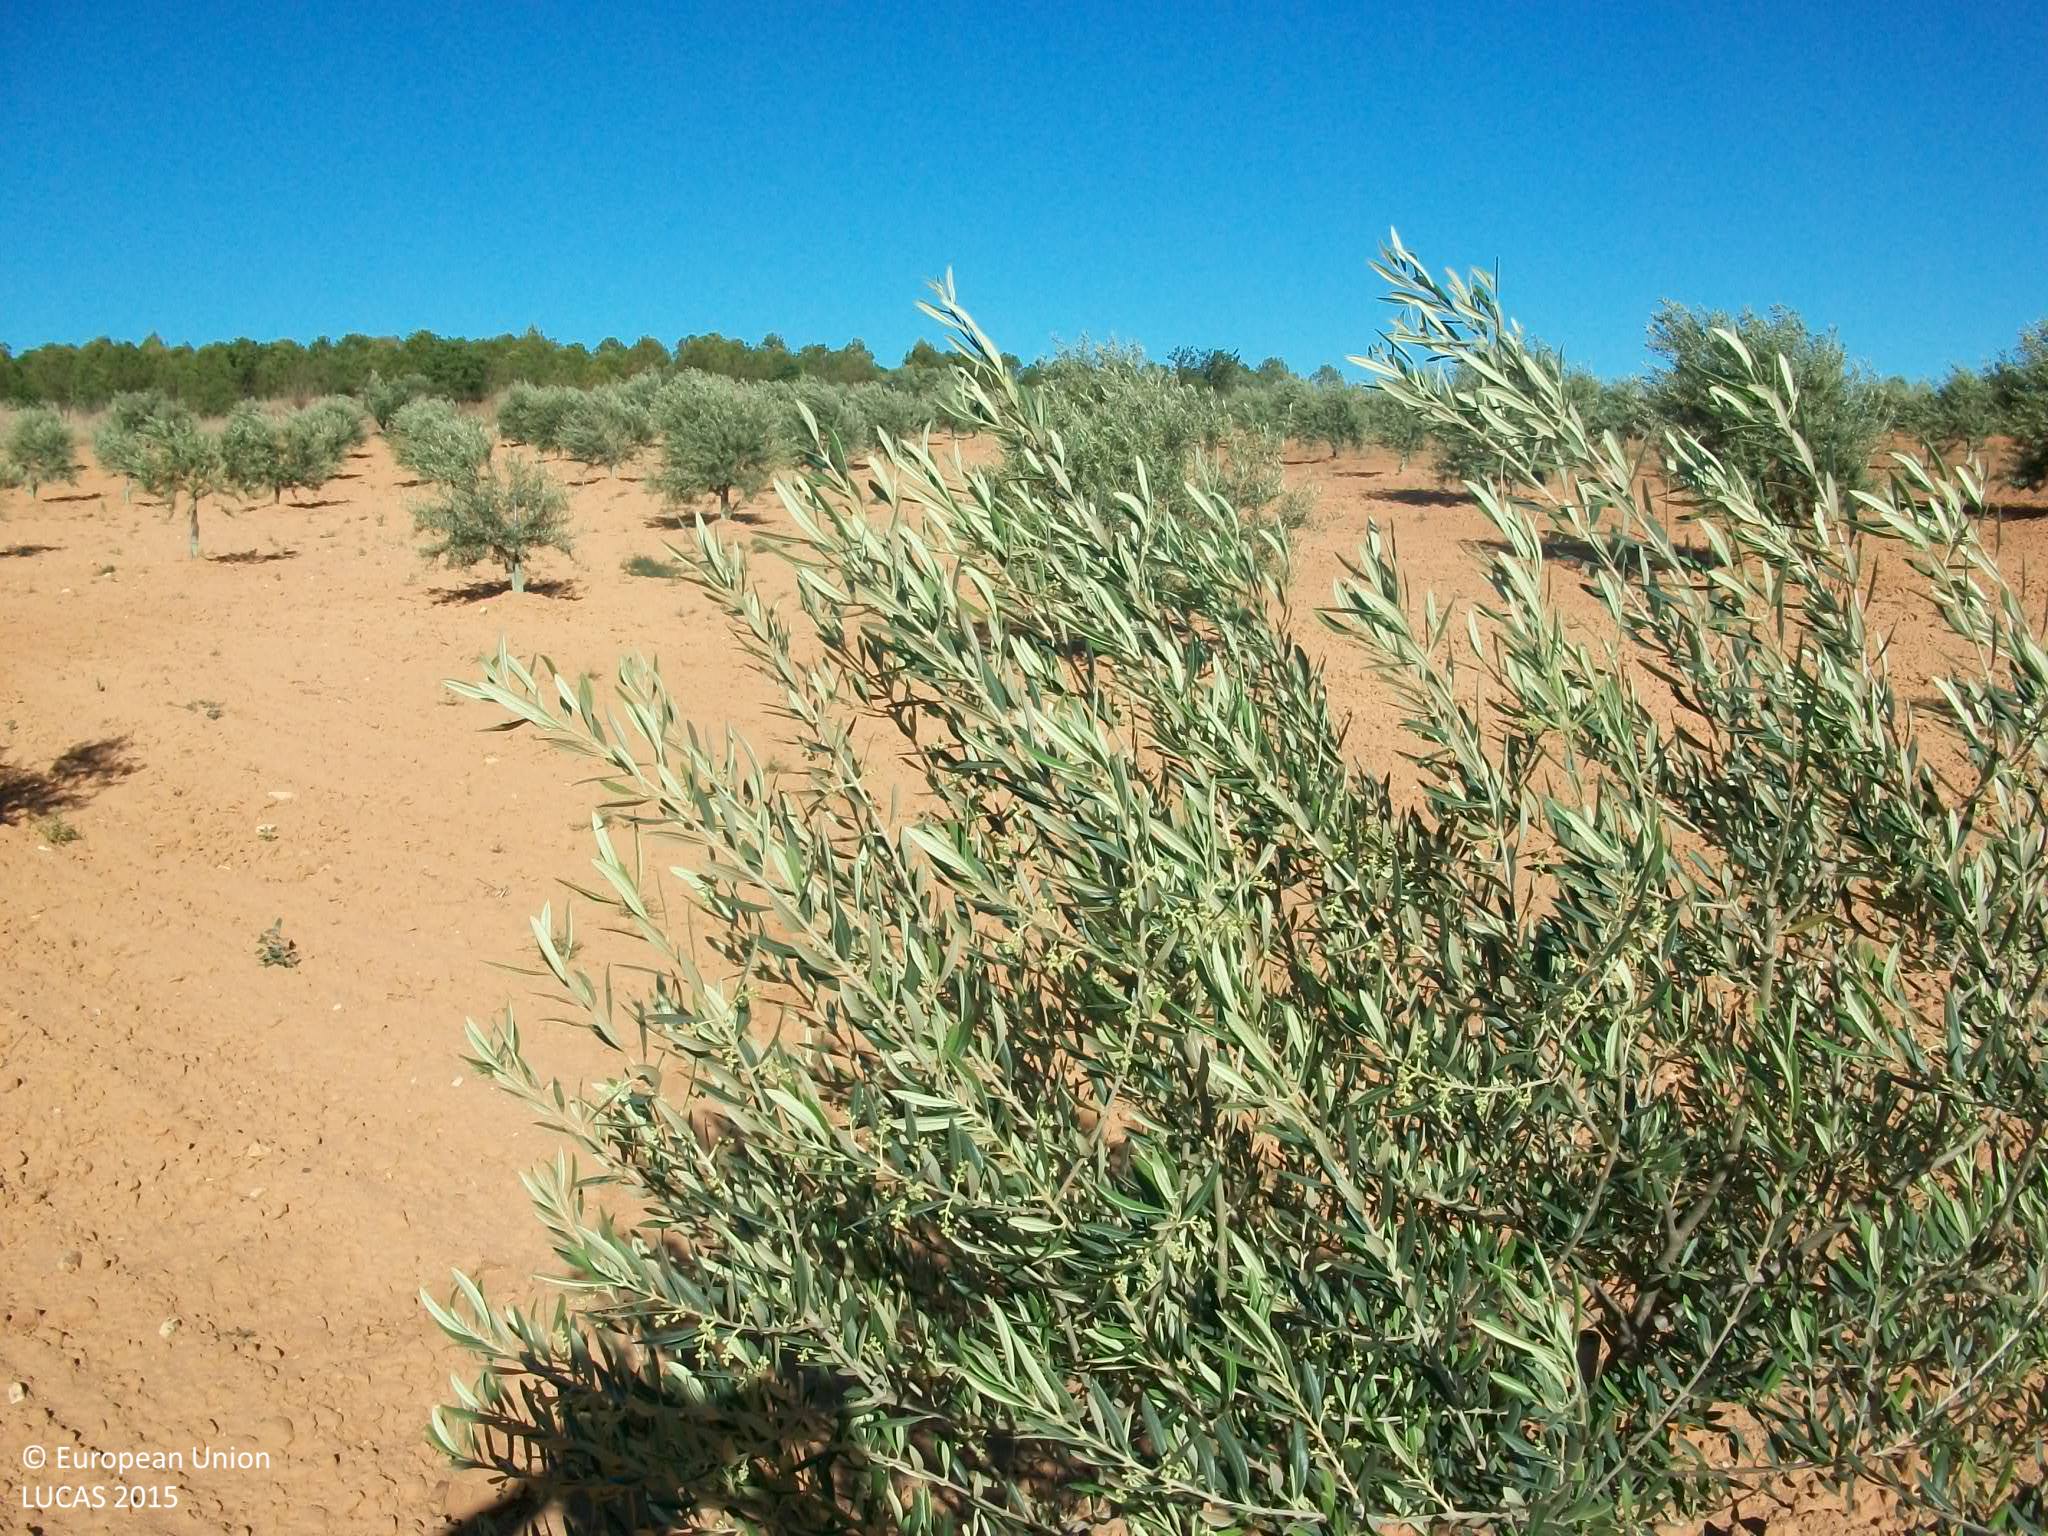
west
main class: Cropland
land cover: Olive groves
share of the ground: 25 - 50 %
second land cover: Other bare soil
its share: > 75 %
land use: Agriculture (excluding fallow land and kitchen gardens)
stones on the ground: < 10 %
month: May
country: ES
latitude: 39.8341
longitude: -3.6894
